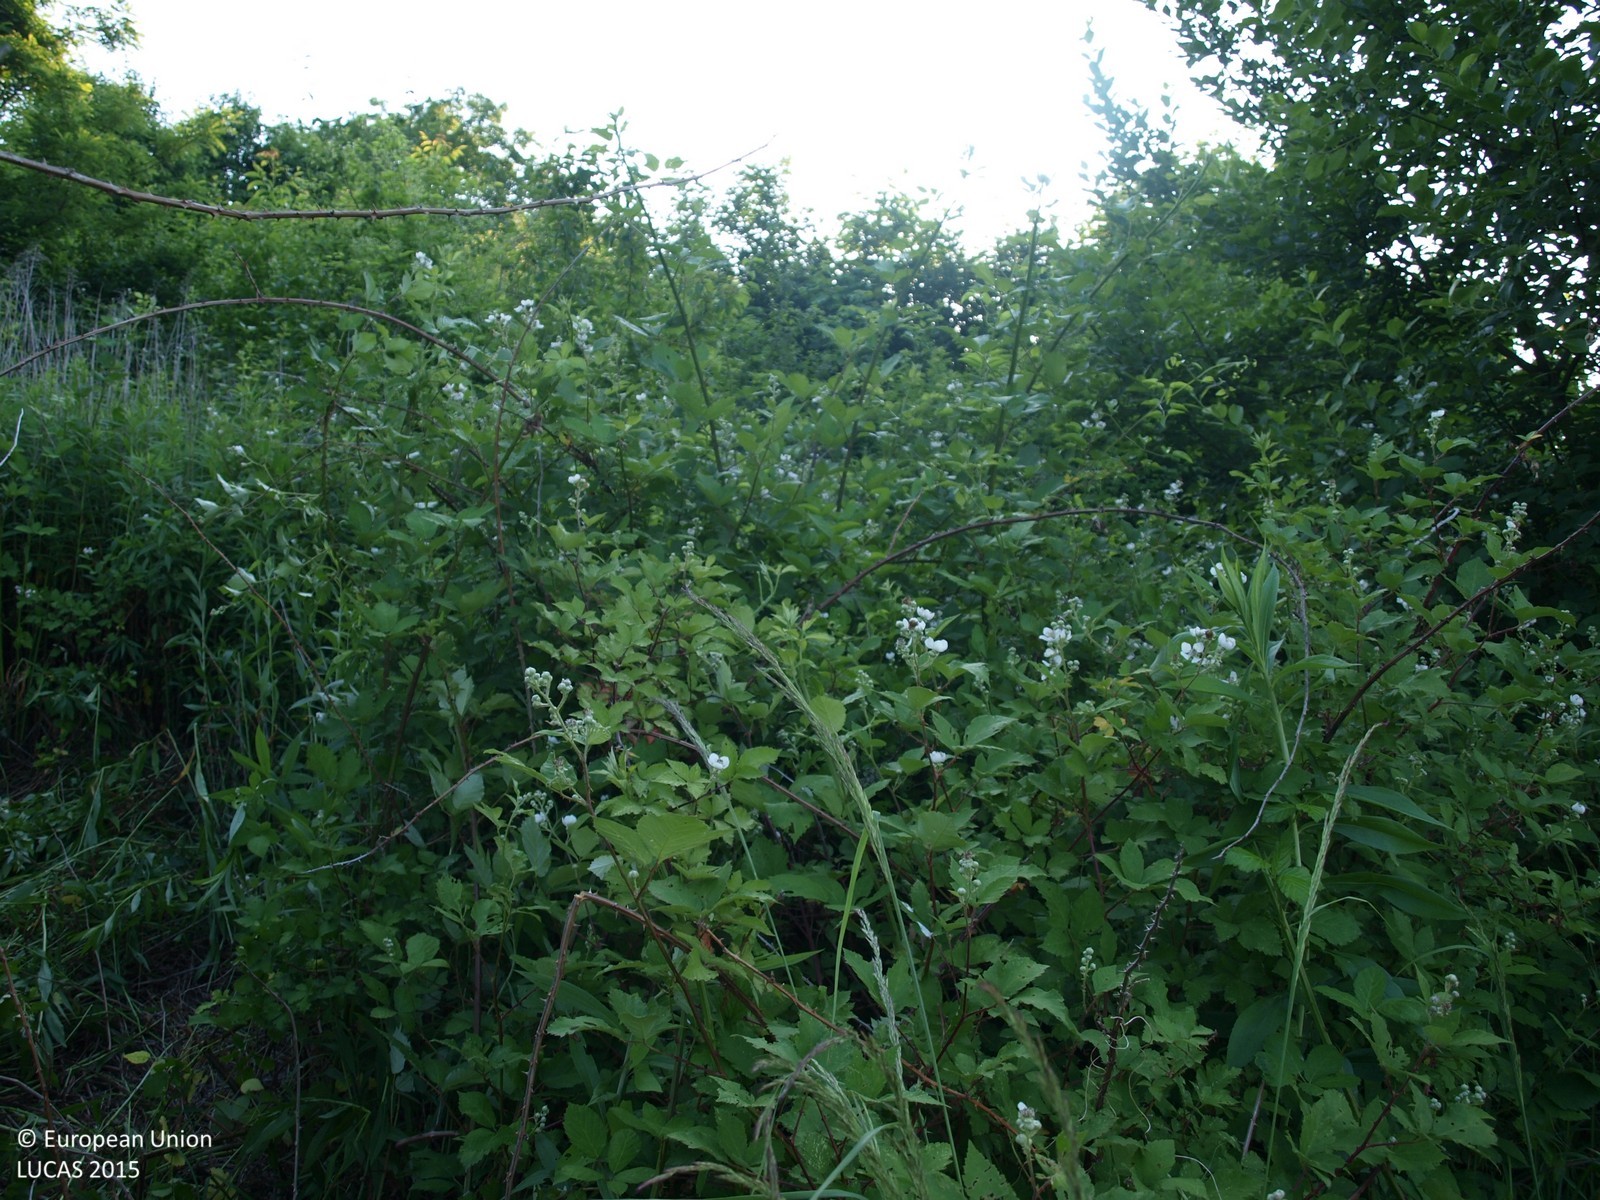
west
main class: Shrubland
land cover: Shrubland with sparse tree cover
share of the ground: > 75 %
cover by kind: shrubs 85 %, herbaceous plants 10 %, broadleaved forest trees 5 %
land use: Semi-natural and natural areas not in use
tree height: < 5 m
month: June
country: HR
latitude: 46.2174
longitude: 16.0270
